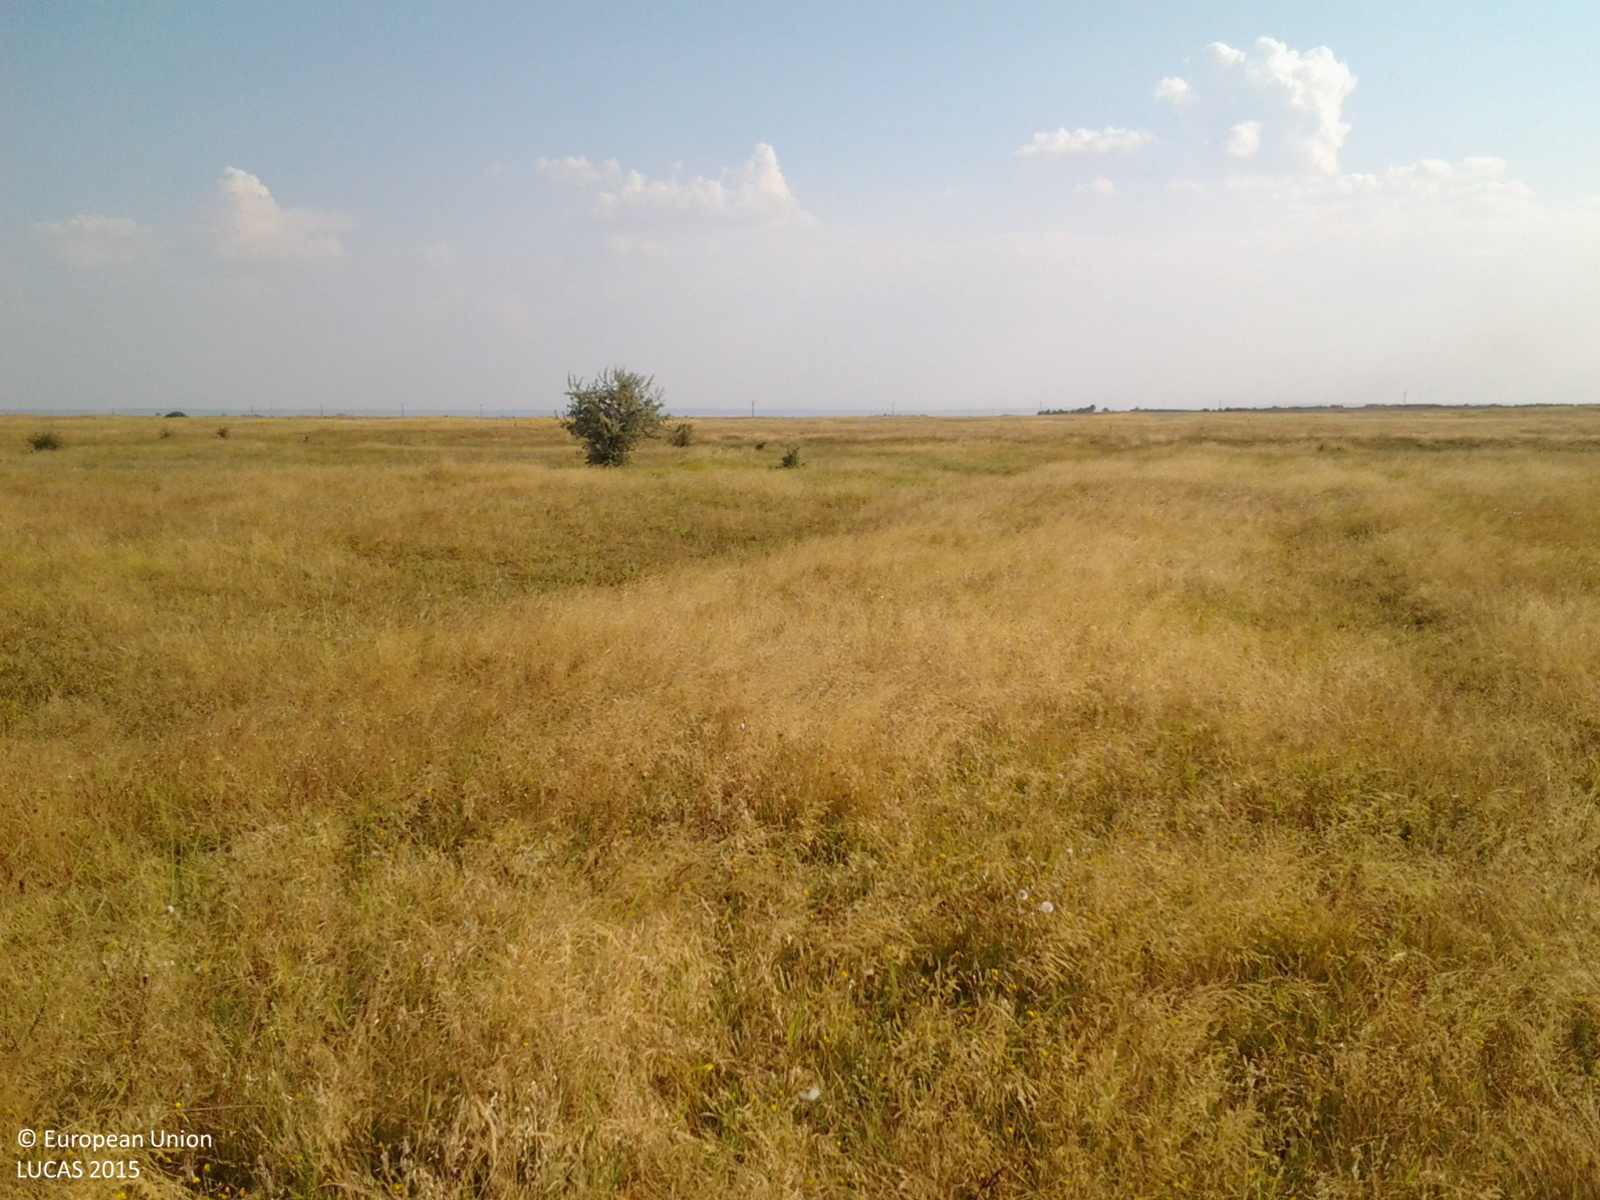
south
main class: Grassland
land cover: Spontaneously vegetated surfaces
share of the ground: > 75 %
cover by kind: herbaceous plants 100 %
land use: Fallow land
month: August
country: RO
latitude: 43.9117
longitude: 23.0037
